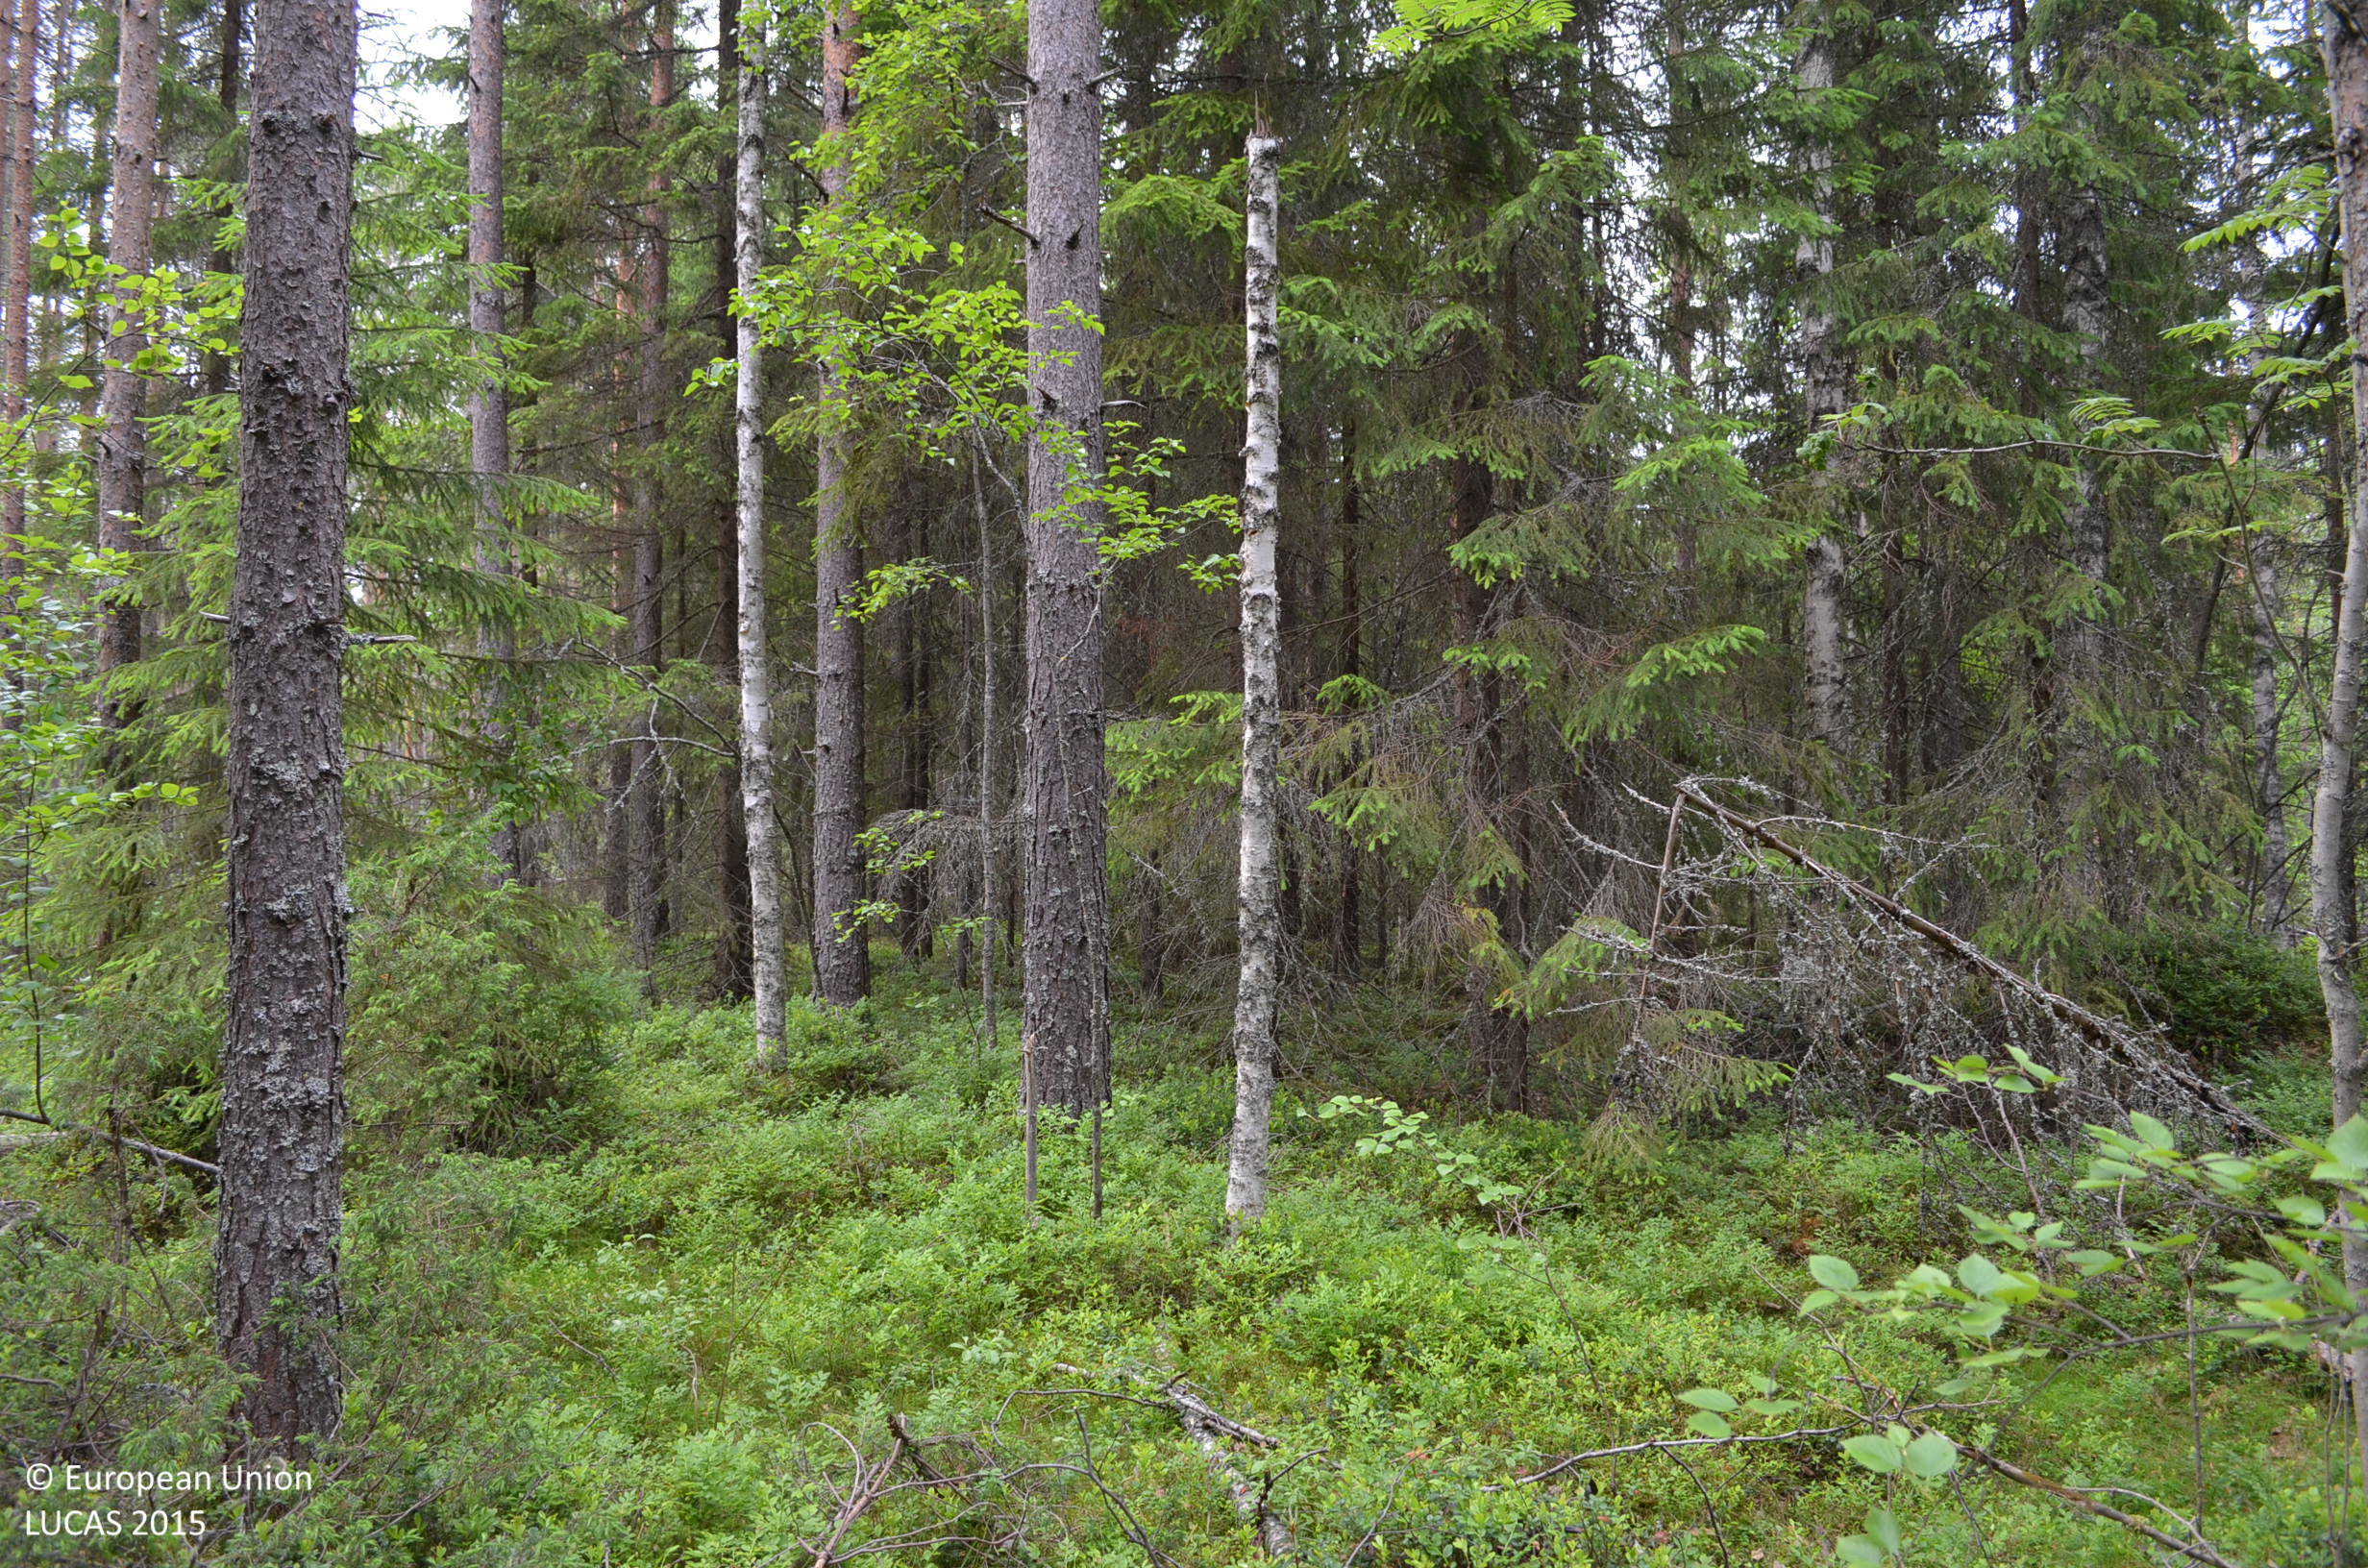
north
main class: Woodland
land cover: Other coniferous woodland
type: boreal forest
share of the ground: > 75 %
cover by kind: coniferous forest trees 60 %, broadleaved forest trees 20 %, shrubs 20 %
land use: Forestry
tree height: > 5 m
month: June
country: FI
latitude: 62.0924
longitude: 23.5000
